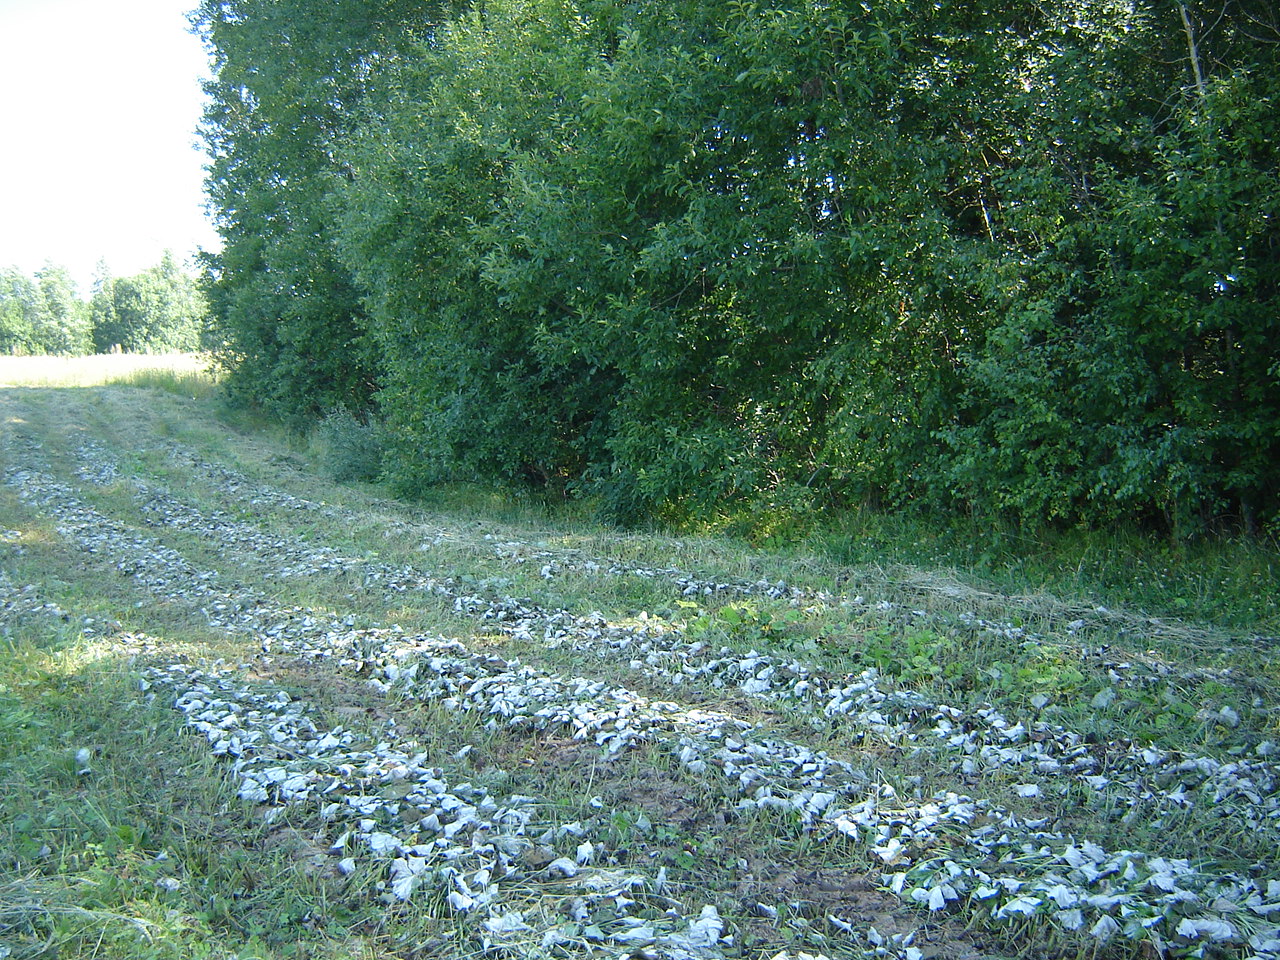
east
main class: Grassland
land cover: Grassland without tree/shrub cover
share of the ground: > 75 %
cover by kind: herbaceous plants 100 %
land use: Agriculture (excluding fallow land and kitchen gardens)
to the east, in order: Grassland without tree/shrub cover; Broadleaved woodland; Grass margins; Common wheat; Grassland without tree/shrub cover; Broadleaved woodland; Ditches and canals; Broadleaved woodland; Grassland without tree/shrub cover
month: August
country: LT
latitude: 55.2078
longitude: 24.9942
